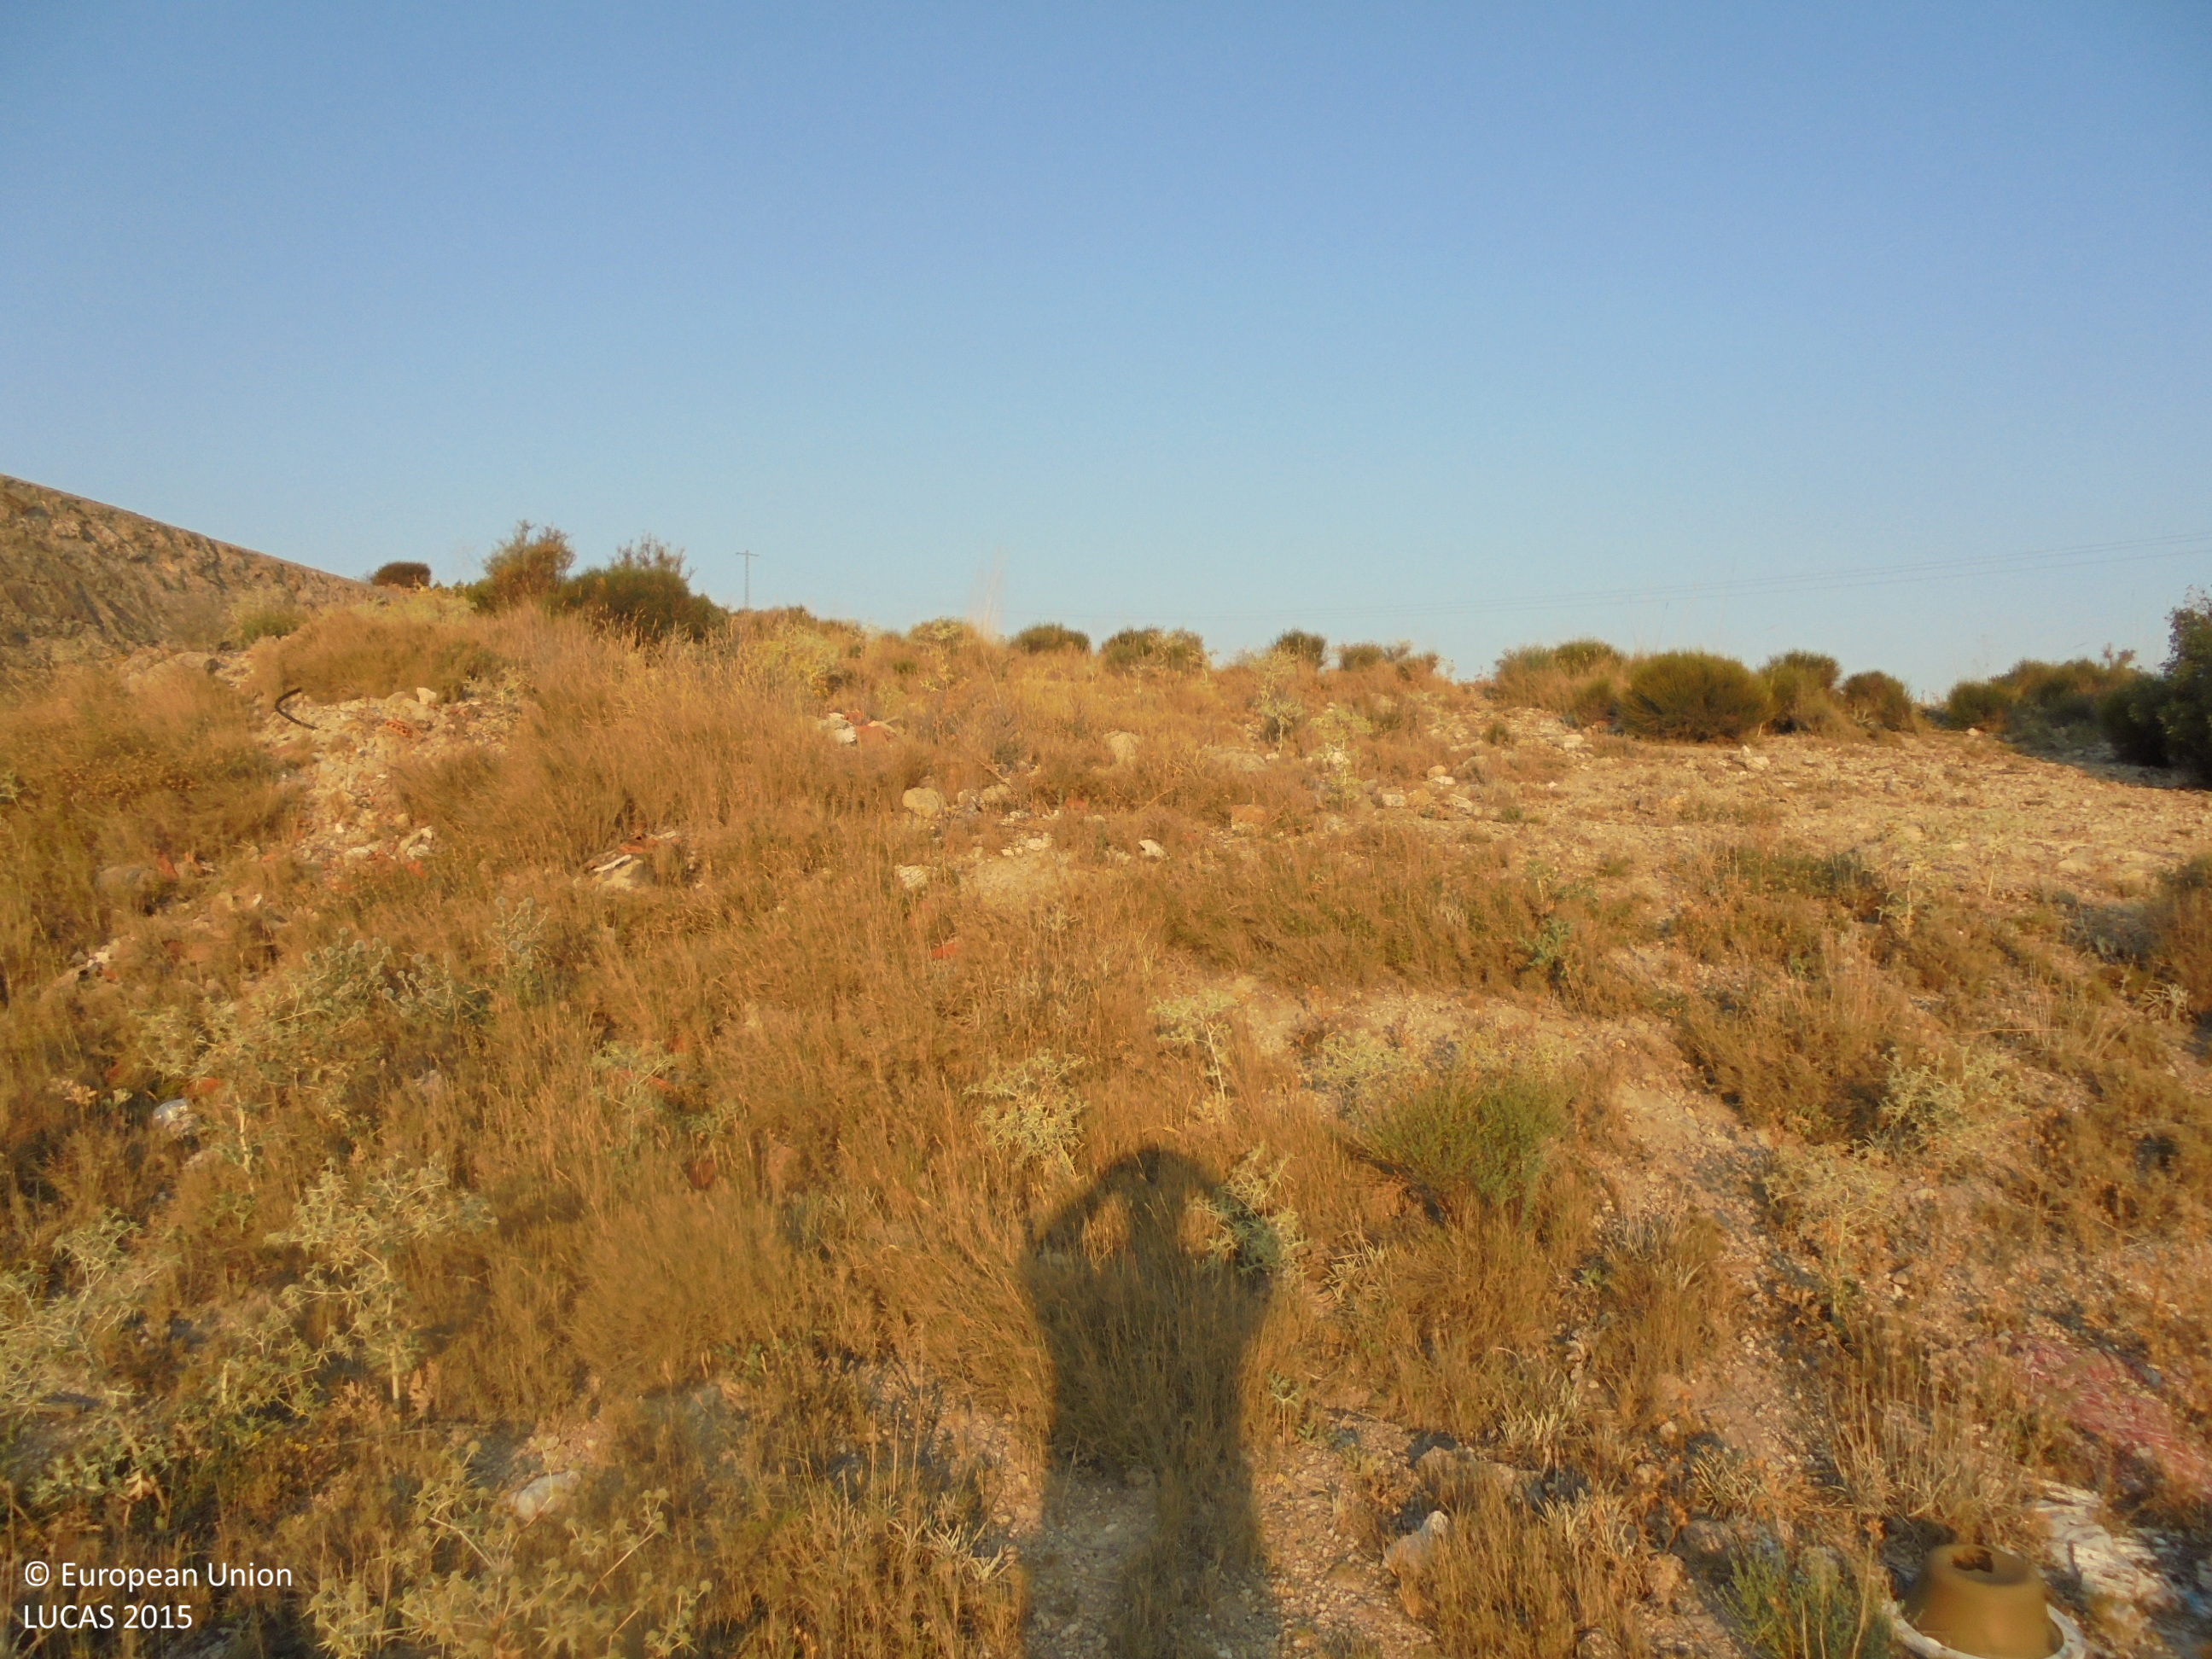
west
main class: Shrubland
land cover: Shrubland without tree cover
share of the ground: 25 - 50 %
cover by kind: herbaceous plants 40 %, shrubs 30 %, unconsolidated bare surface 30 %
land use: Semi-natural and natural areas not in use
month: July
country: ES
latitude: 38.7041
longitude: -1.4124
